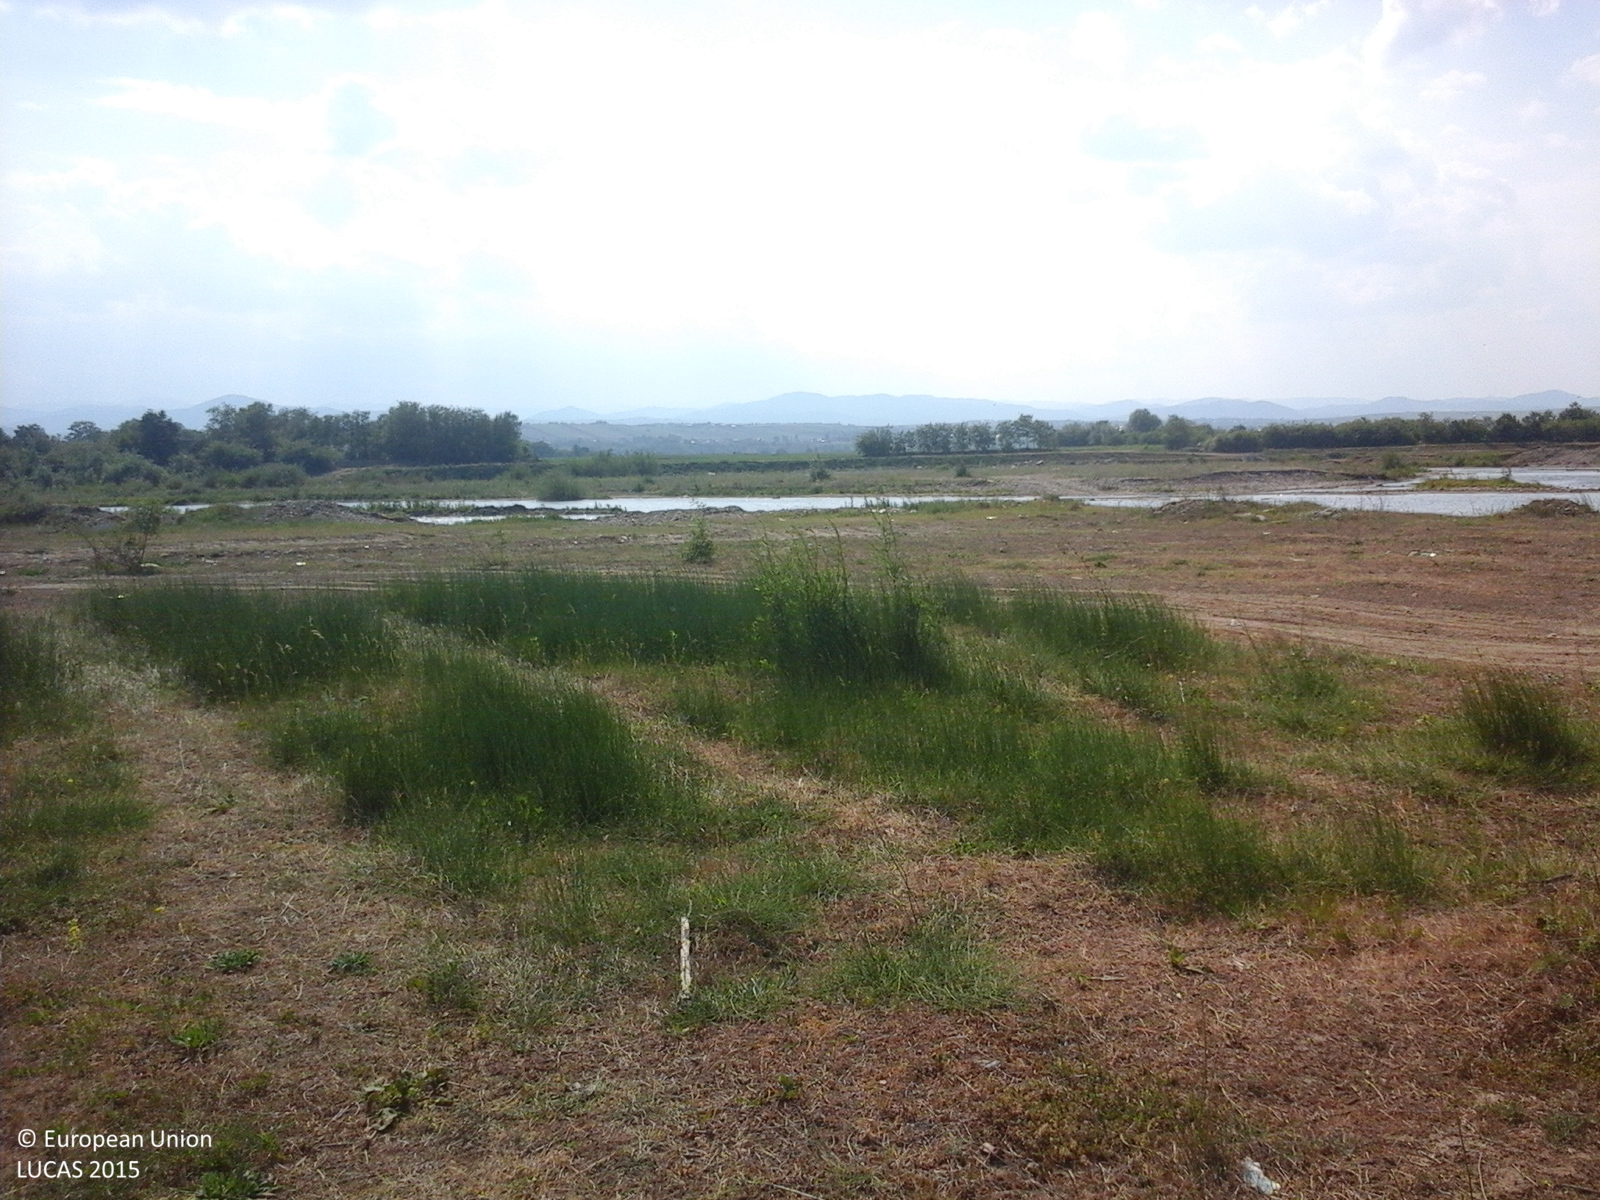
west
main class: Grassland
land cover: Spontaneously vegetated surfaces
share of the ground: > 75 %
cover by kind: herbaceous plants 100 %
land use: Agriculture (excluding fallow land and kitchen gardens)
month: June
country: RO
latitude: 46.7481
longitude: 26.6195
